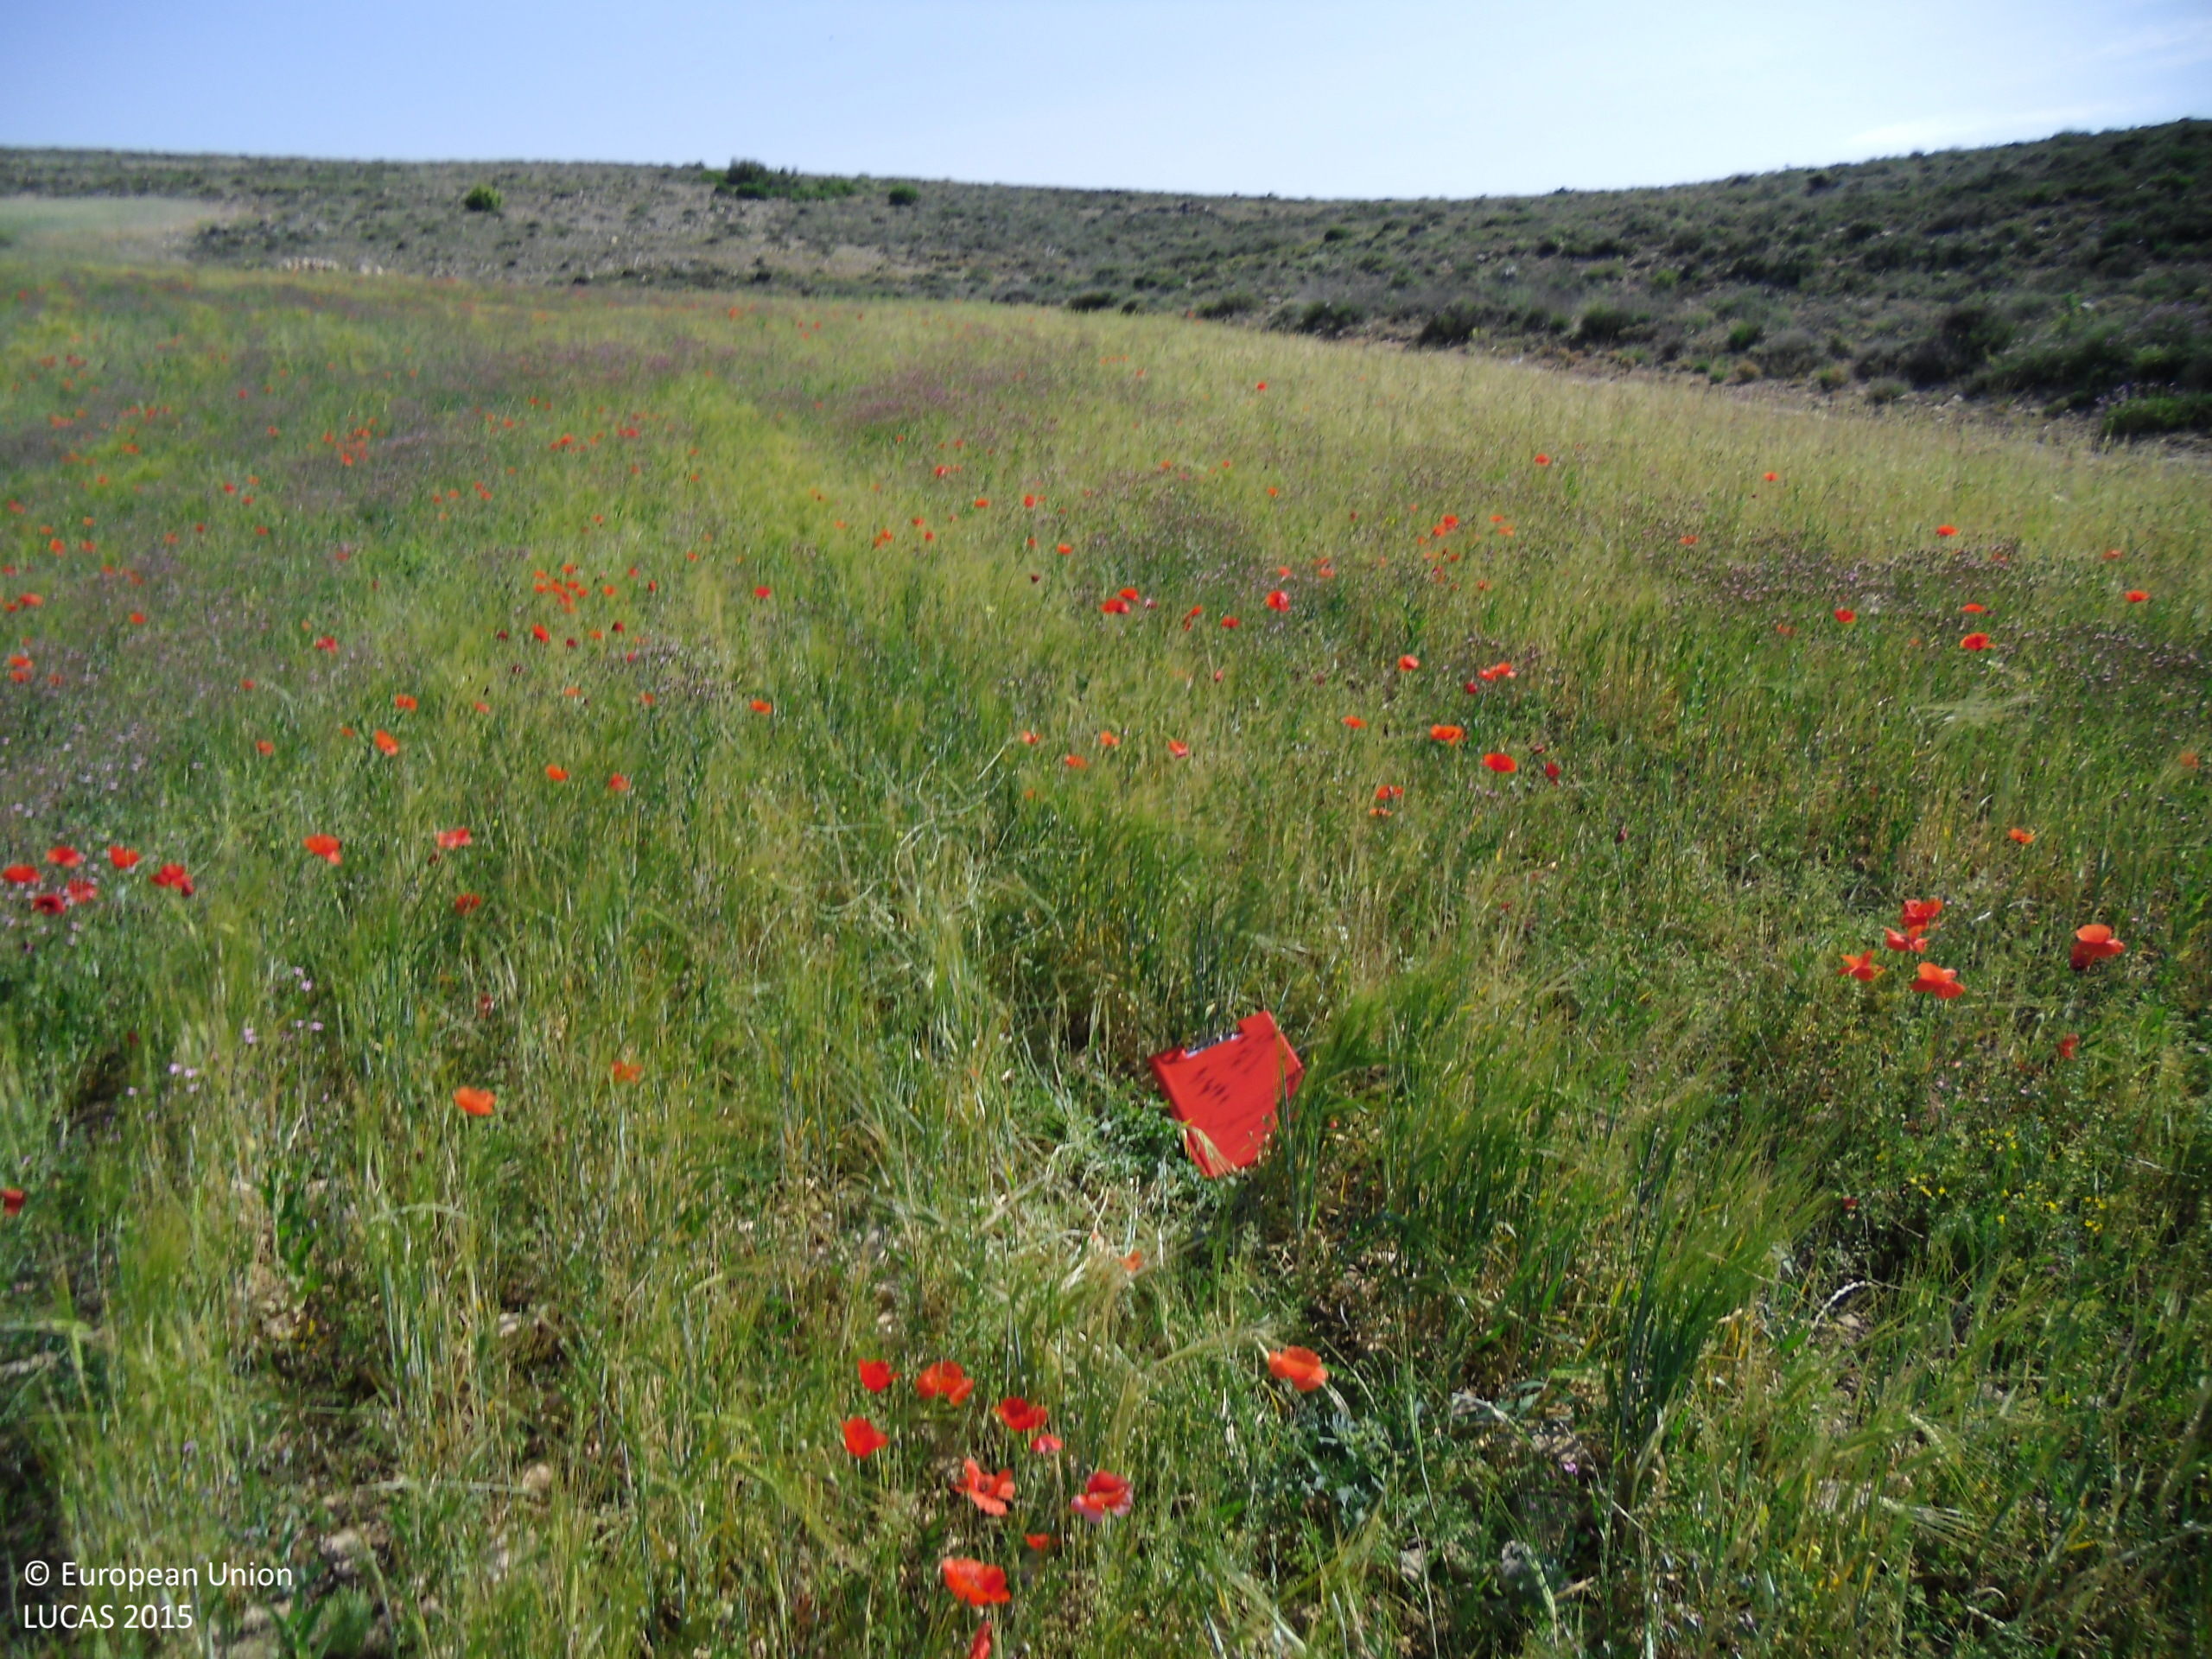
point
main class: Cropland
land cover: Barley
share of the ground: > 75 %
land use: Agriculture (excluding fallow land and kitchen gardens)
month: June
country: ES
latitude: 41.0669
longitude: -0.6897
